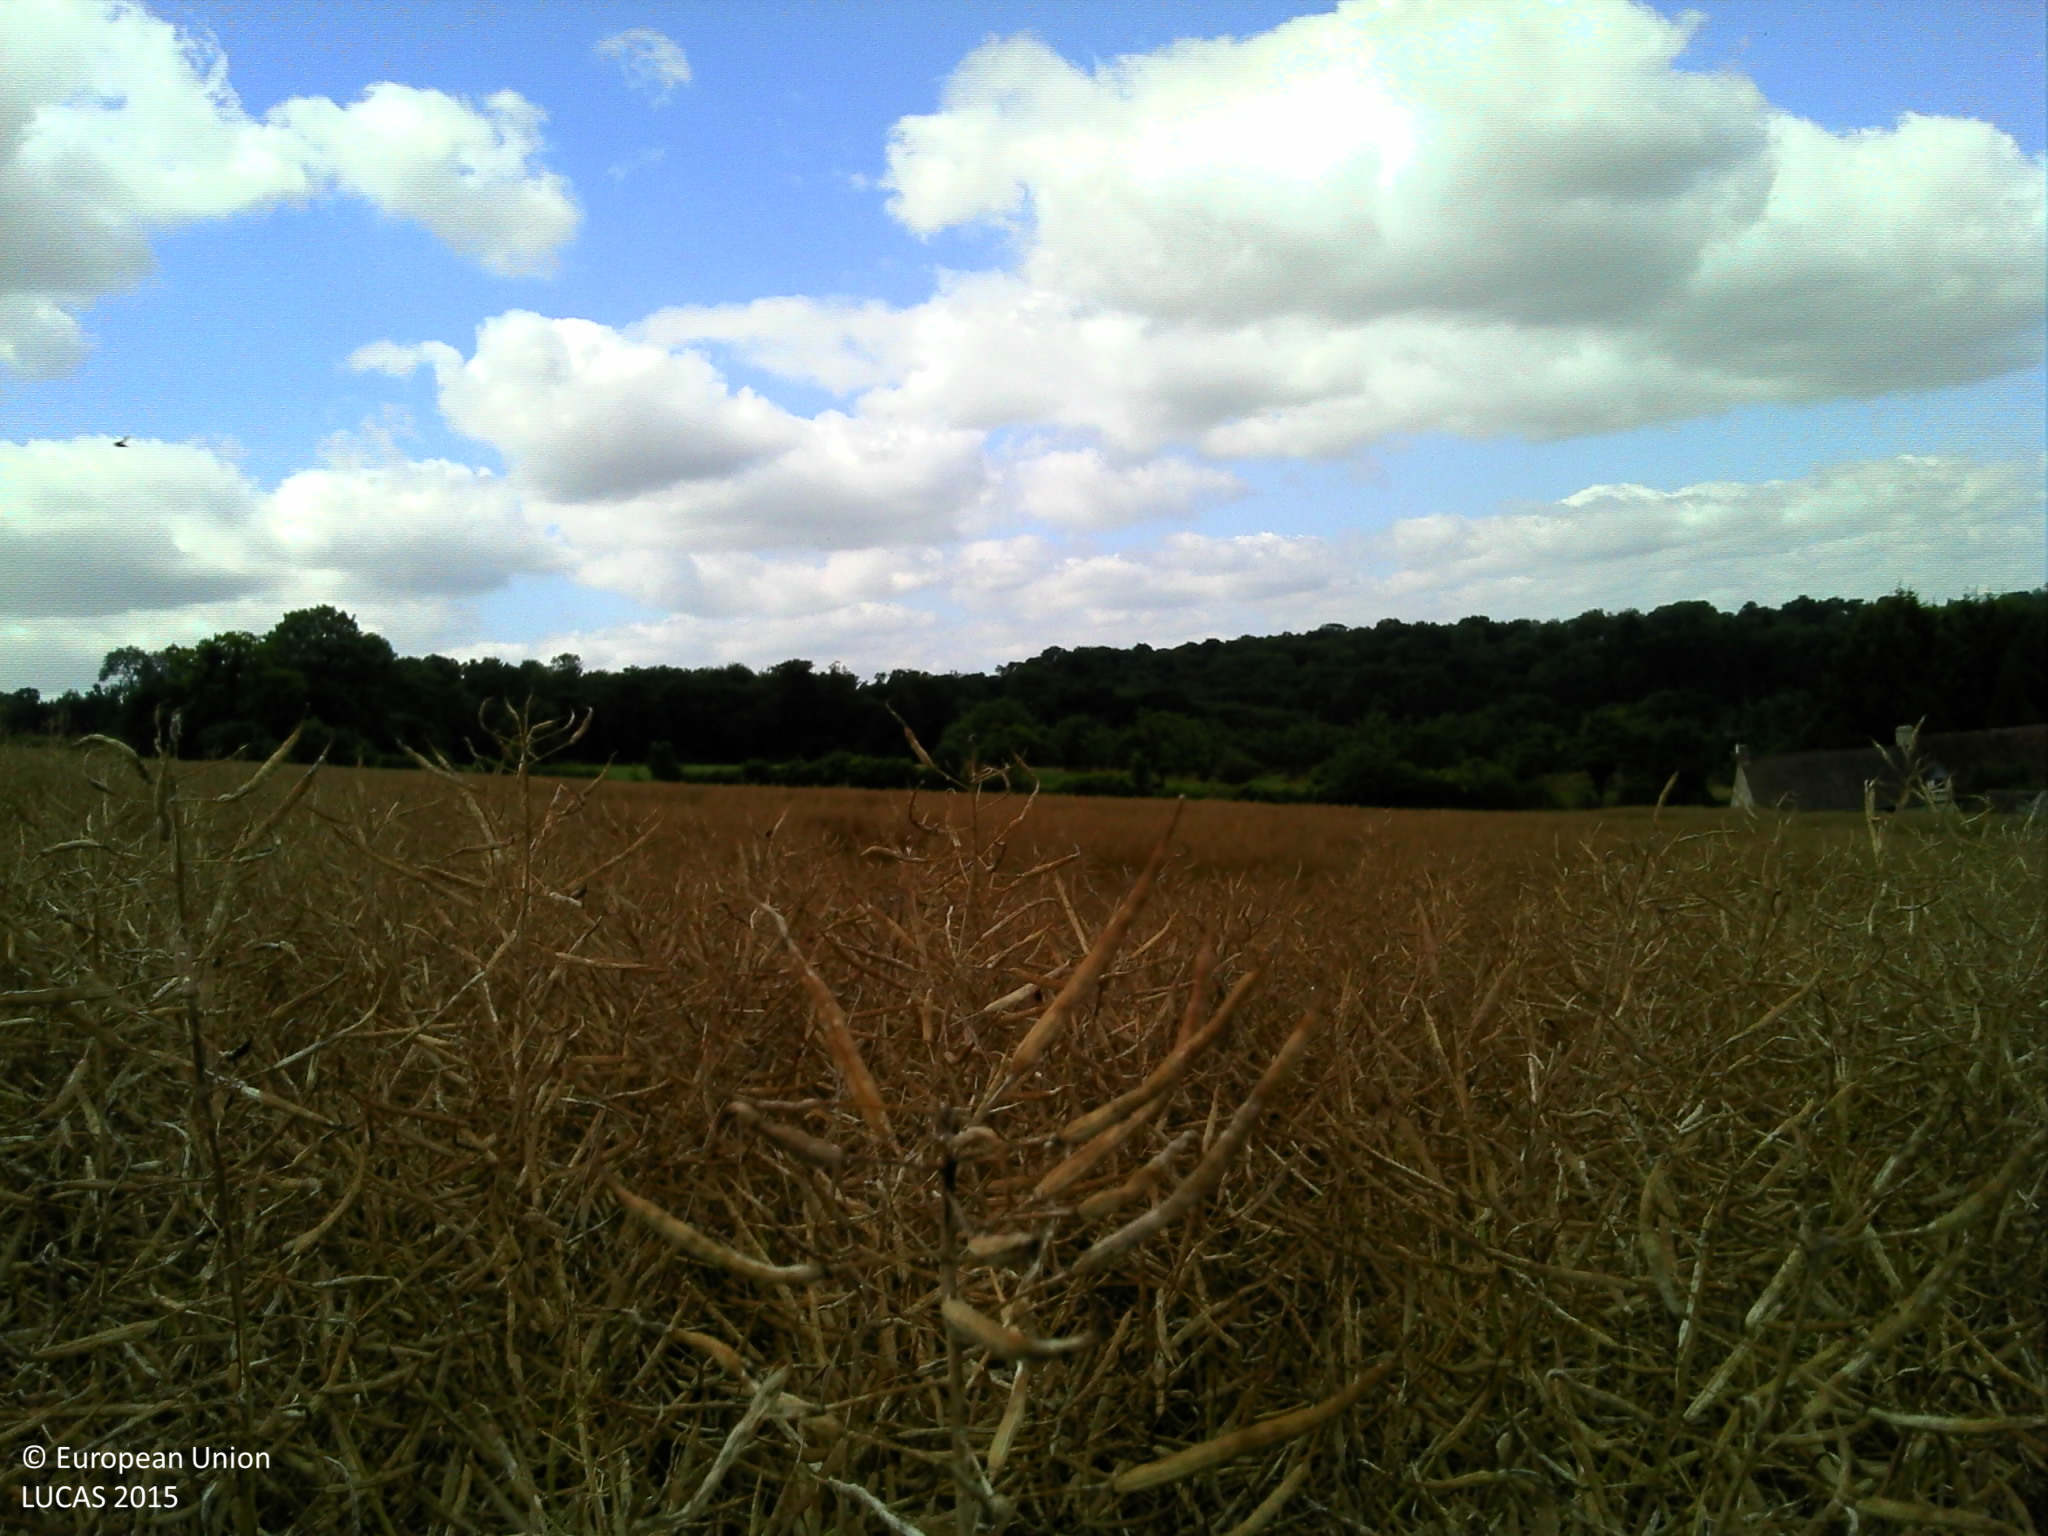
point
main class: Cropland
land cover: Rape and turnip rape
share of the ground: > 75 %
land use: Agriculture (excluding fallow land and kitchen gardens)
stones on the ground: < 10 %
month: July
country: FR
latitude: 48.9812
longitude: -0.2123
